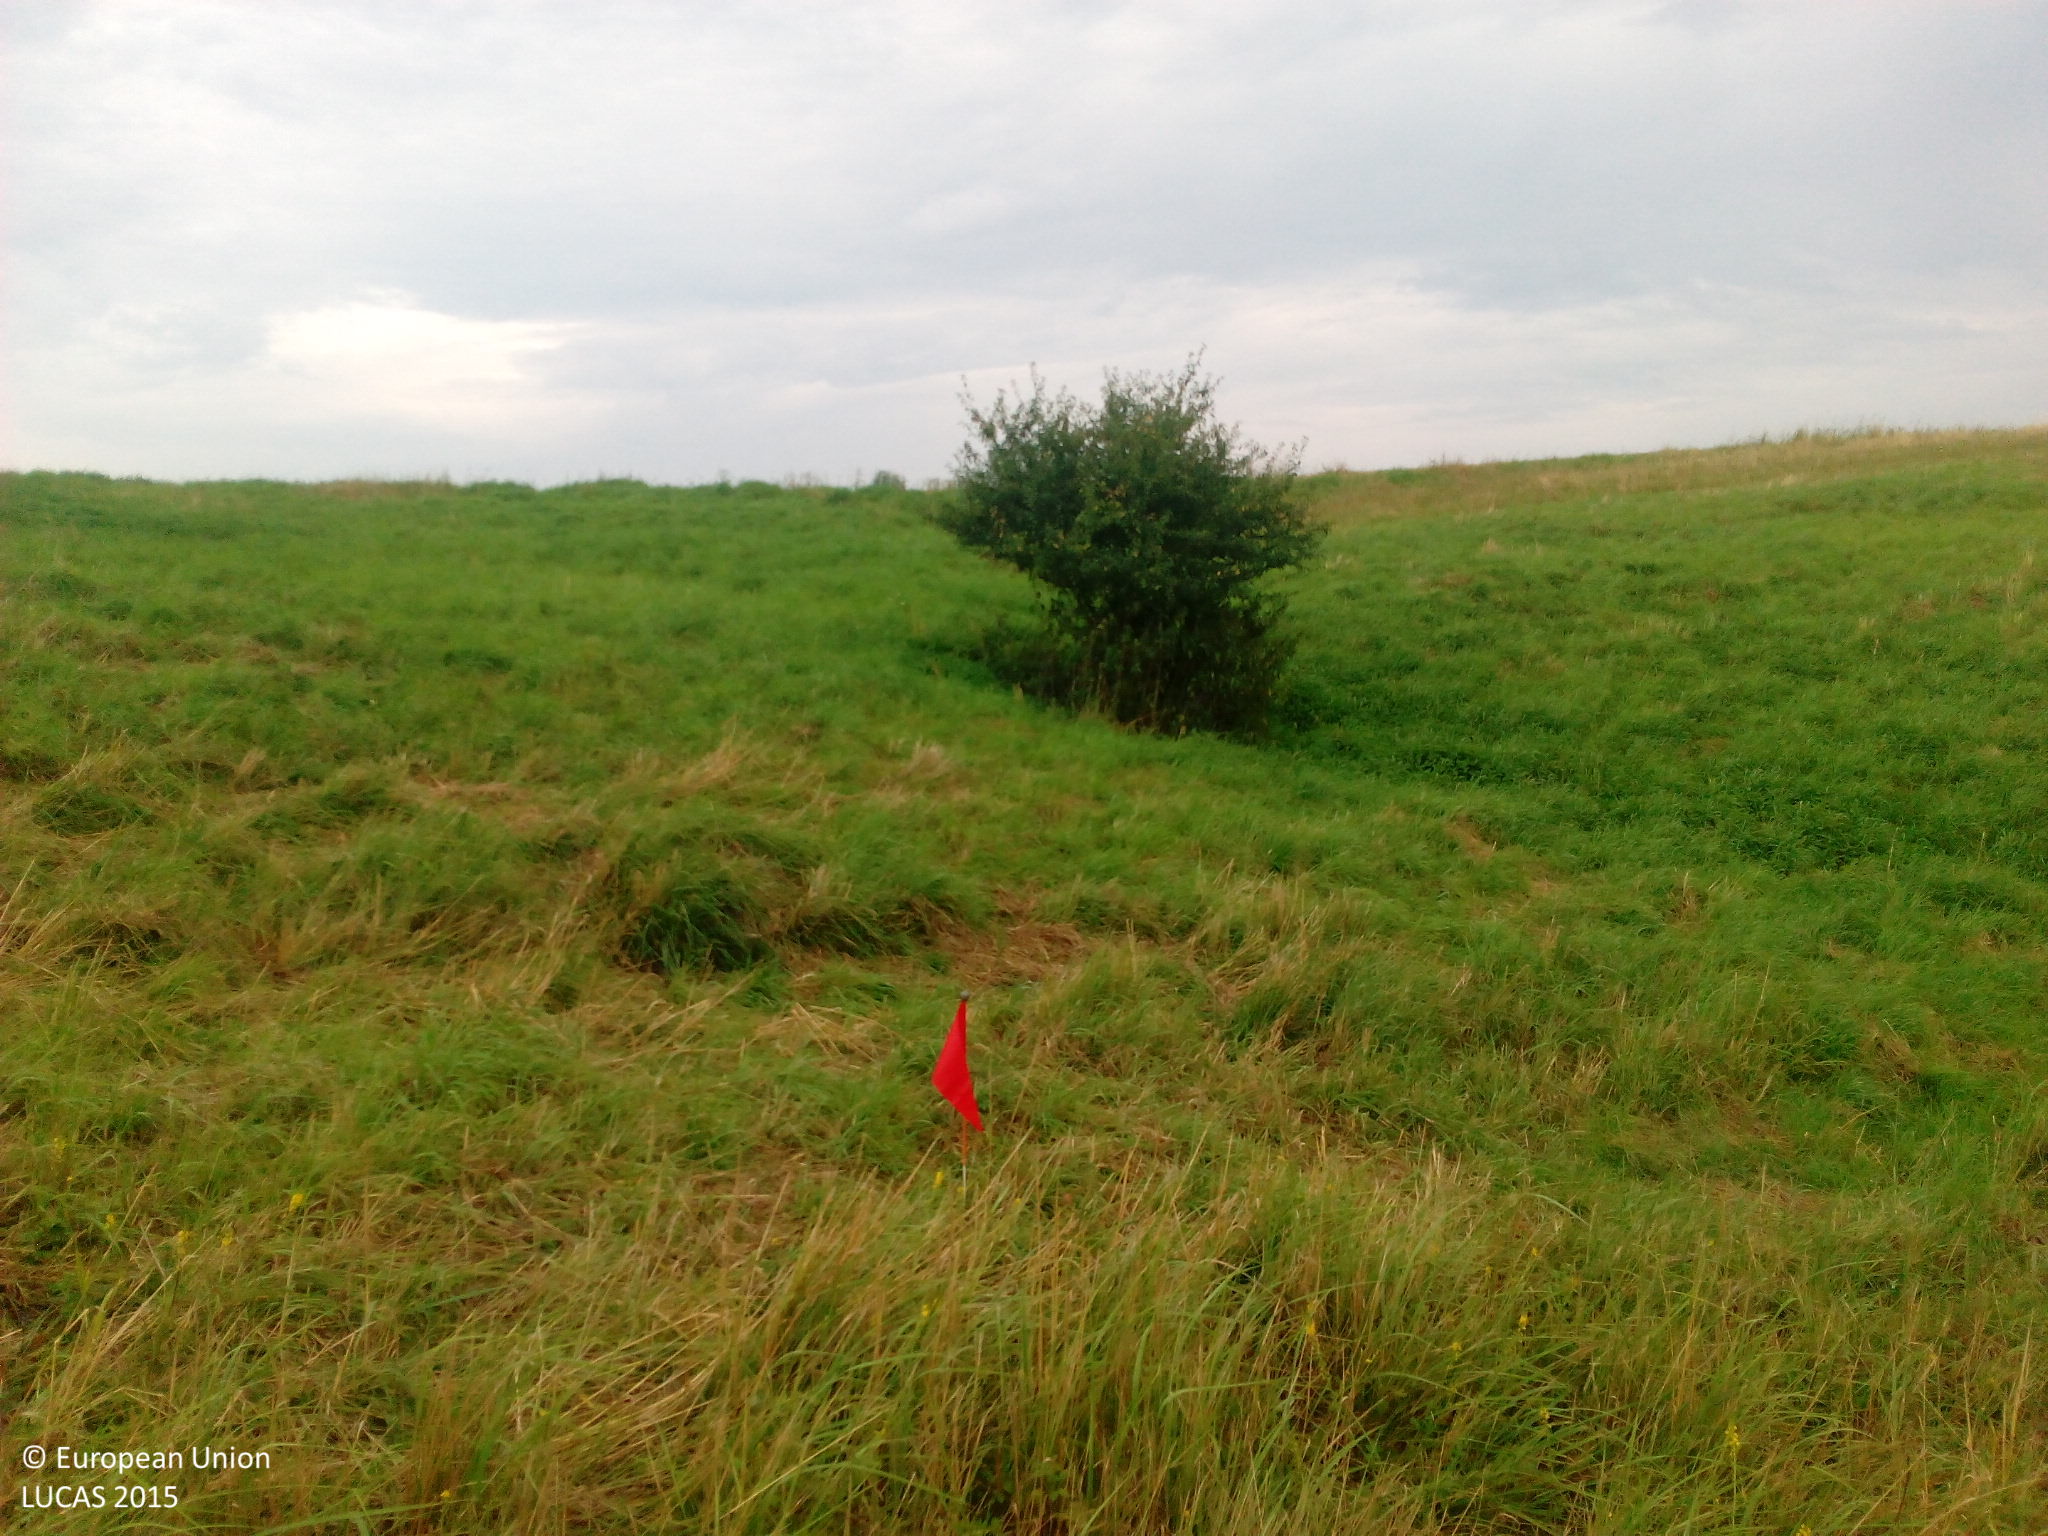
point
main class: Grassland
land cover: Grassland with sparse tree/shrub cover
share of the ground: > 75 %
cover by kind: herbaceous plants 95 %, broadleaved forest trees 5 %
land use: Agriculture (excluding fallow land and kitchen gardens)
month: August
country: DE
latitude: 53.6290
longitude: 13.2204
